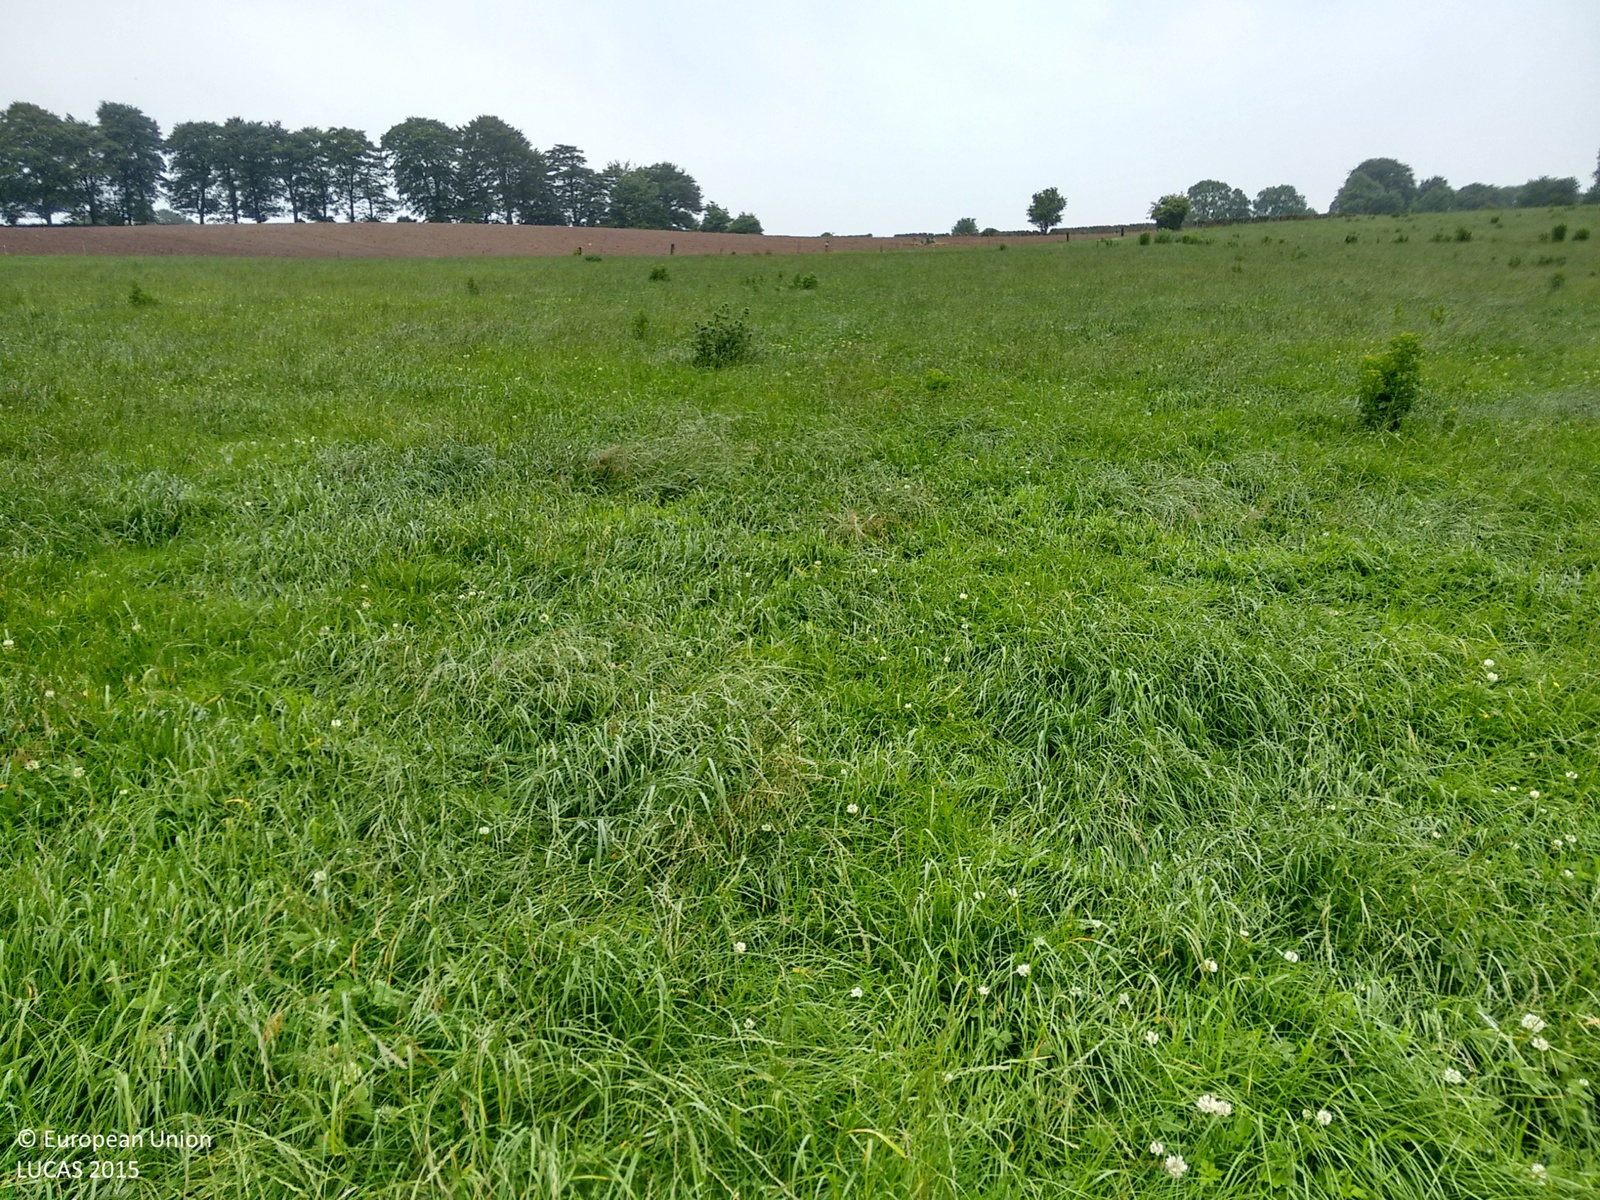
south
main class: Grassland
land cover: Grassland without tree/shrub cover
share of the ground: > 75 %
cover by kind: herbaceous plants 90 %, shrubs 5 %
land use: Agriculture (excluding fallow land and kitchen gardens)
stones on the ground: < 10 %
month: July
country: IE
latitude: 52.2417
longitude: -8.4547
